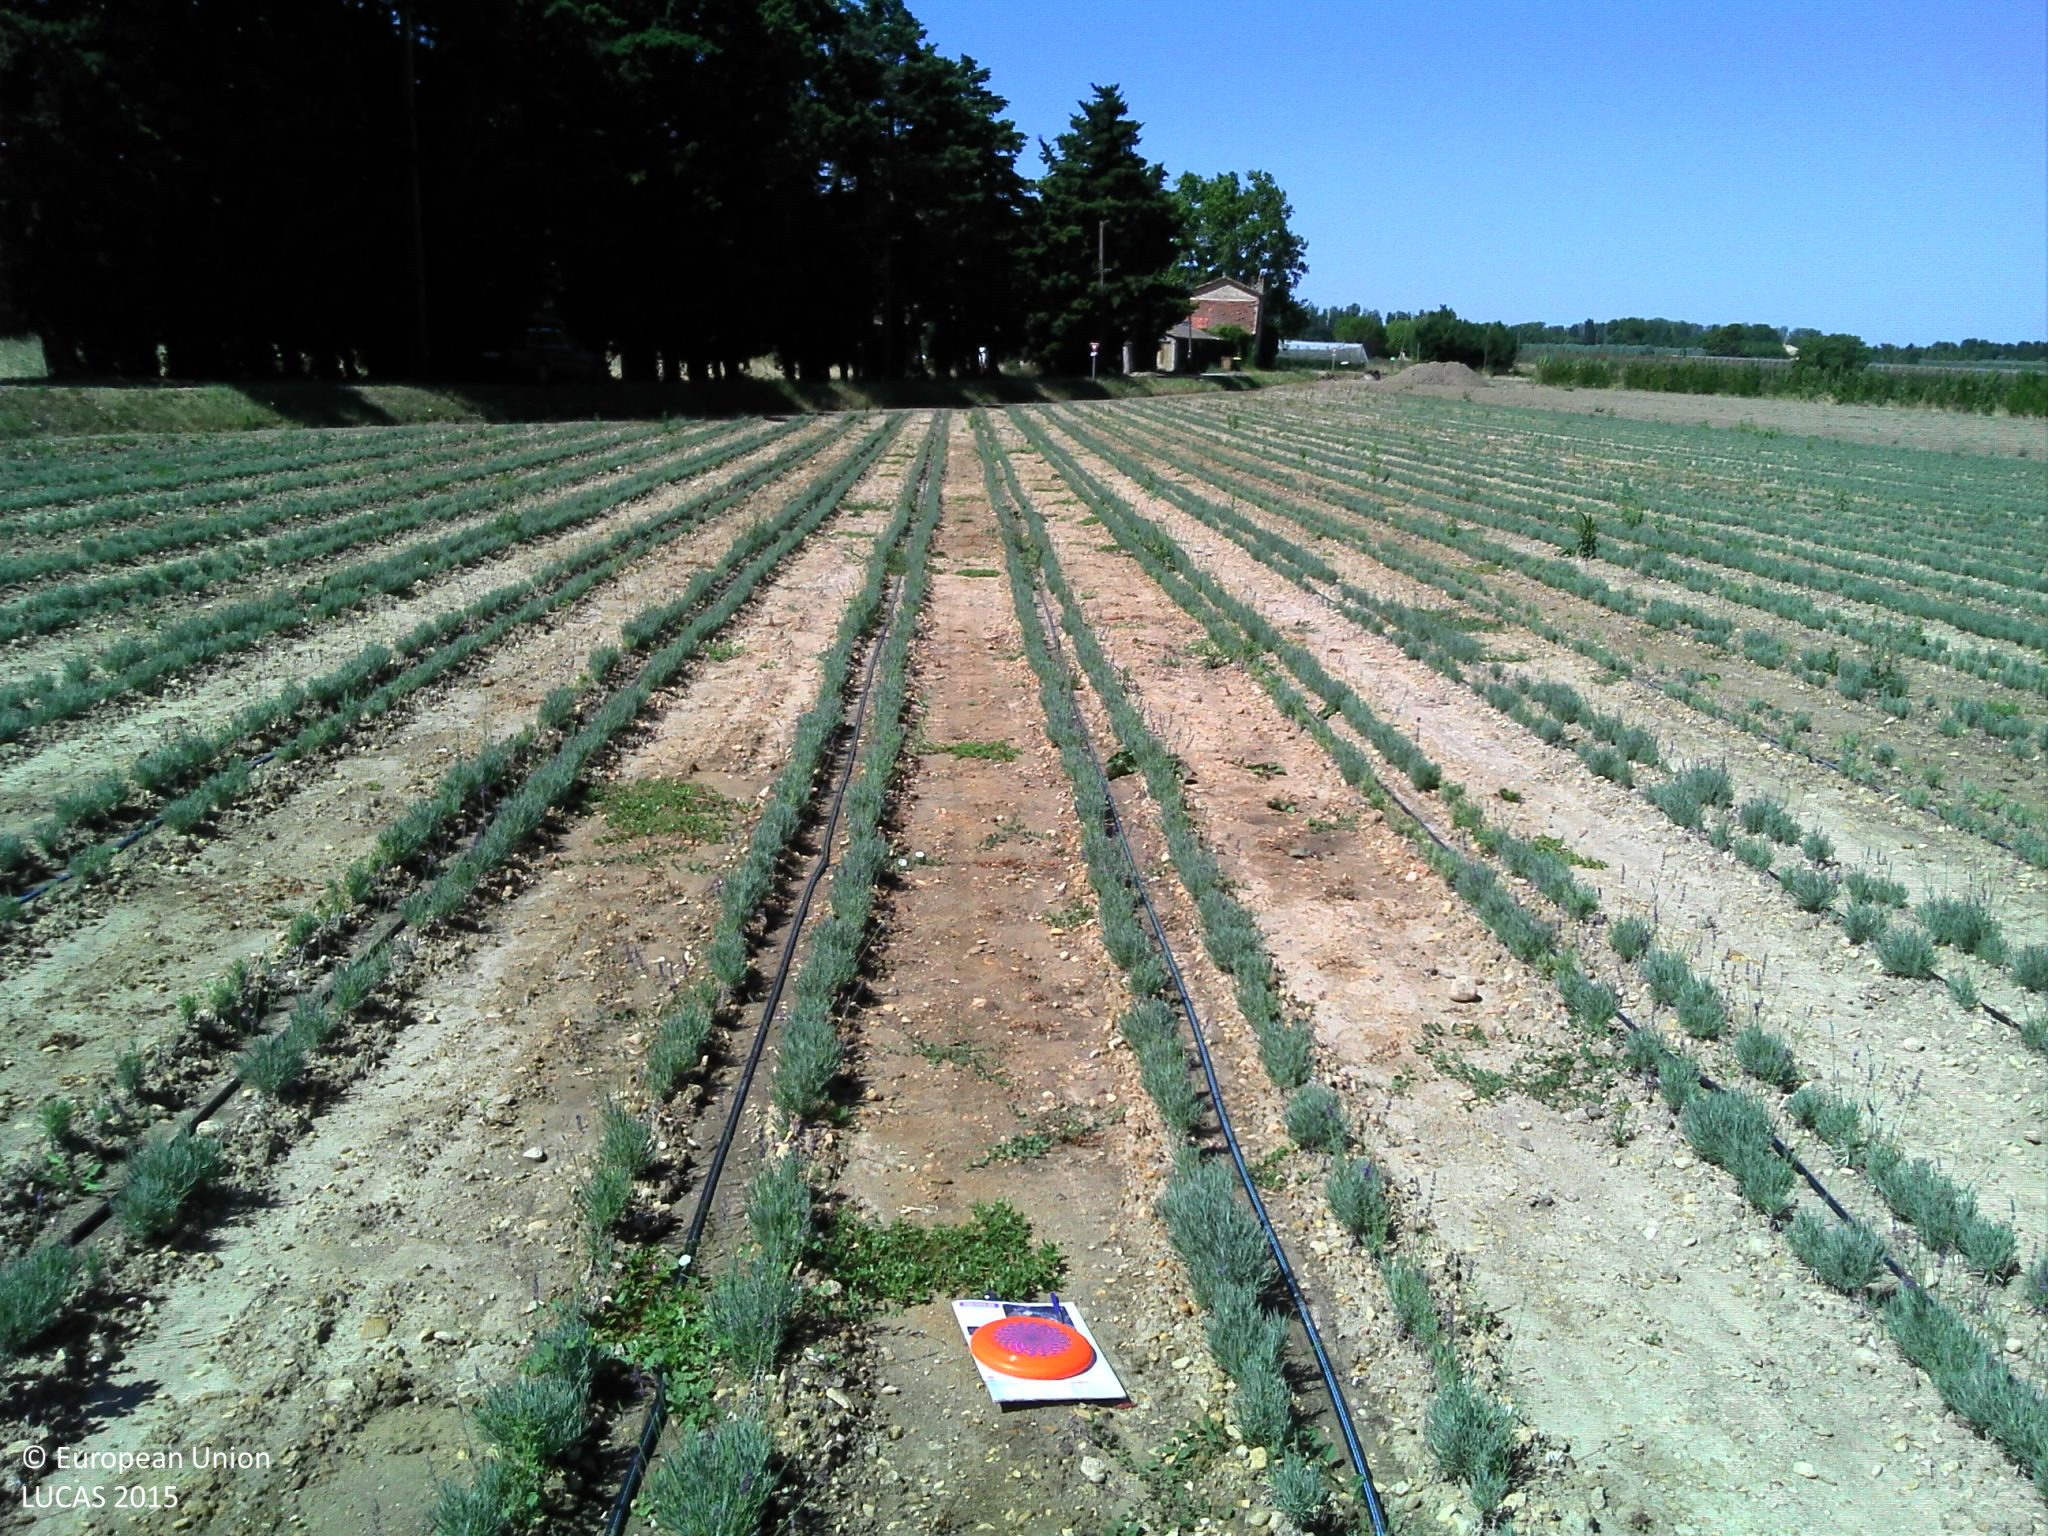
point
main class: Cropland
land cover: Permanent industrial crops
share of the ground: 25 - 50 %
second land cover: Other bare soil
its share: > 75 %
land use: Agriculture (excluding fallow land and kitchen gardens)
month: July
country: FR
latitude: 43.8911
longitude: 5.0917
